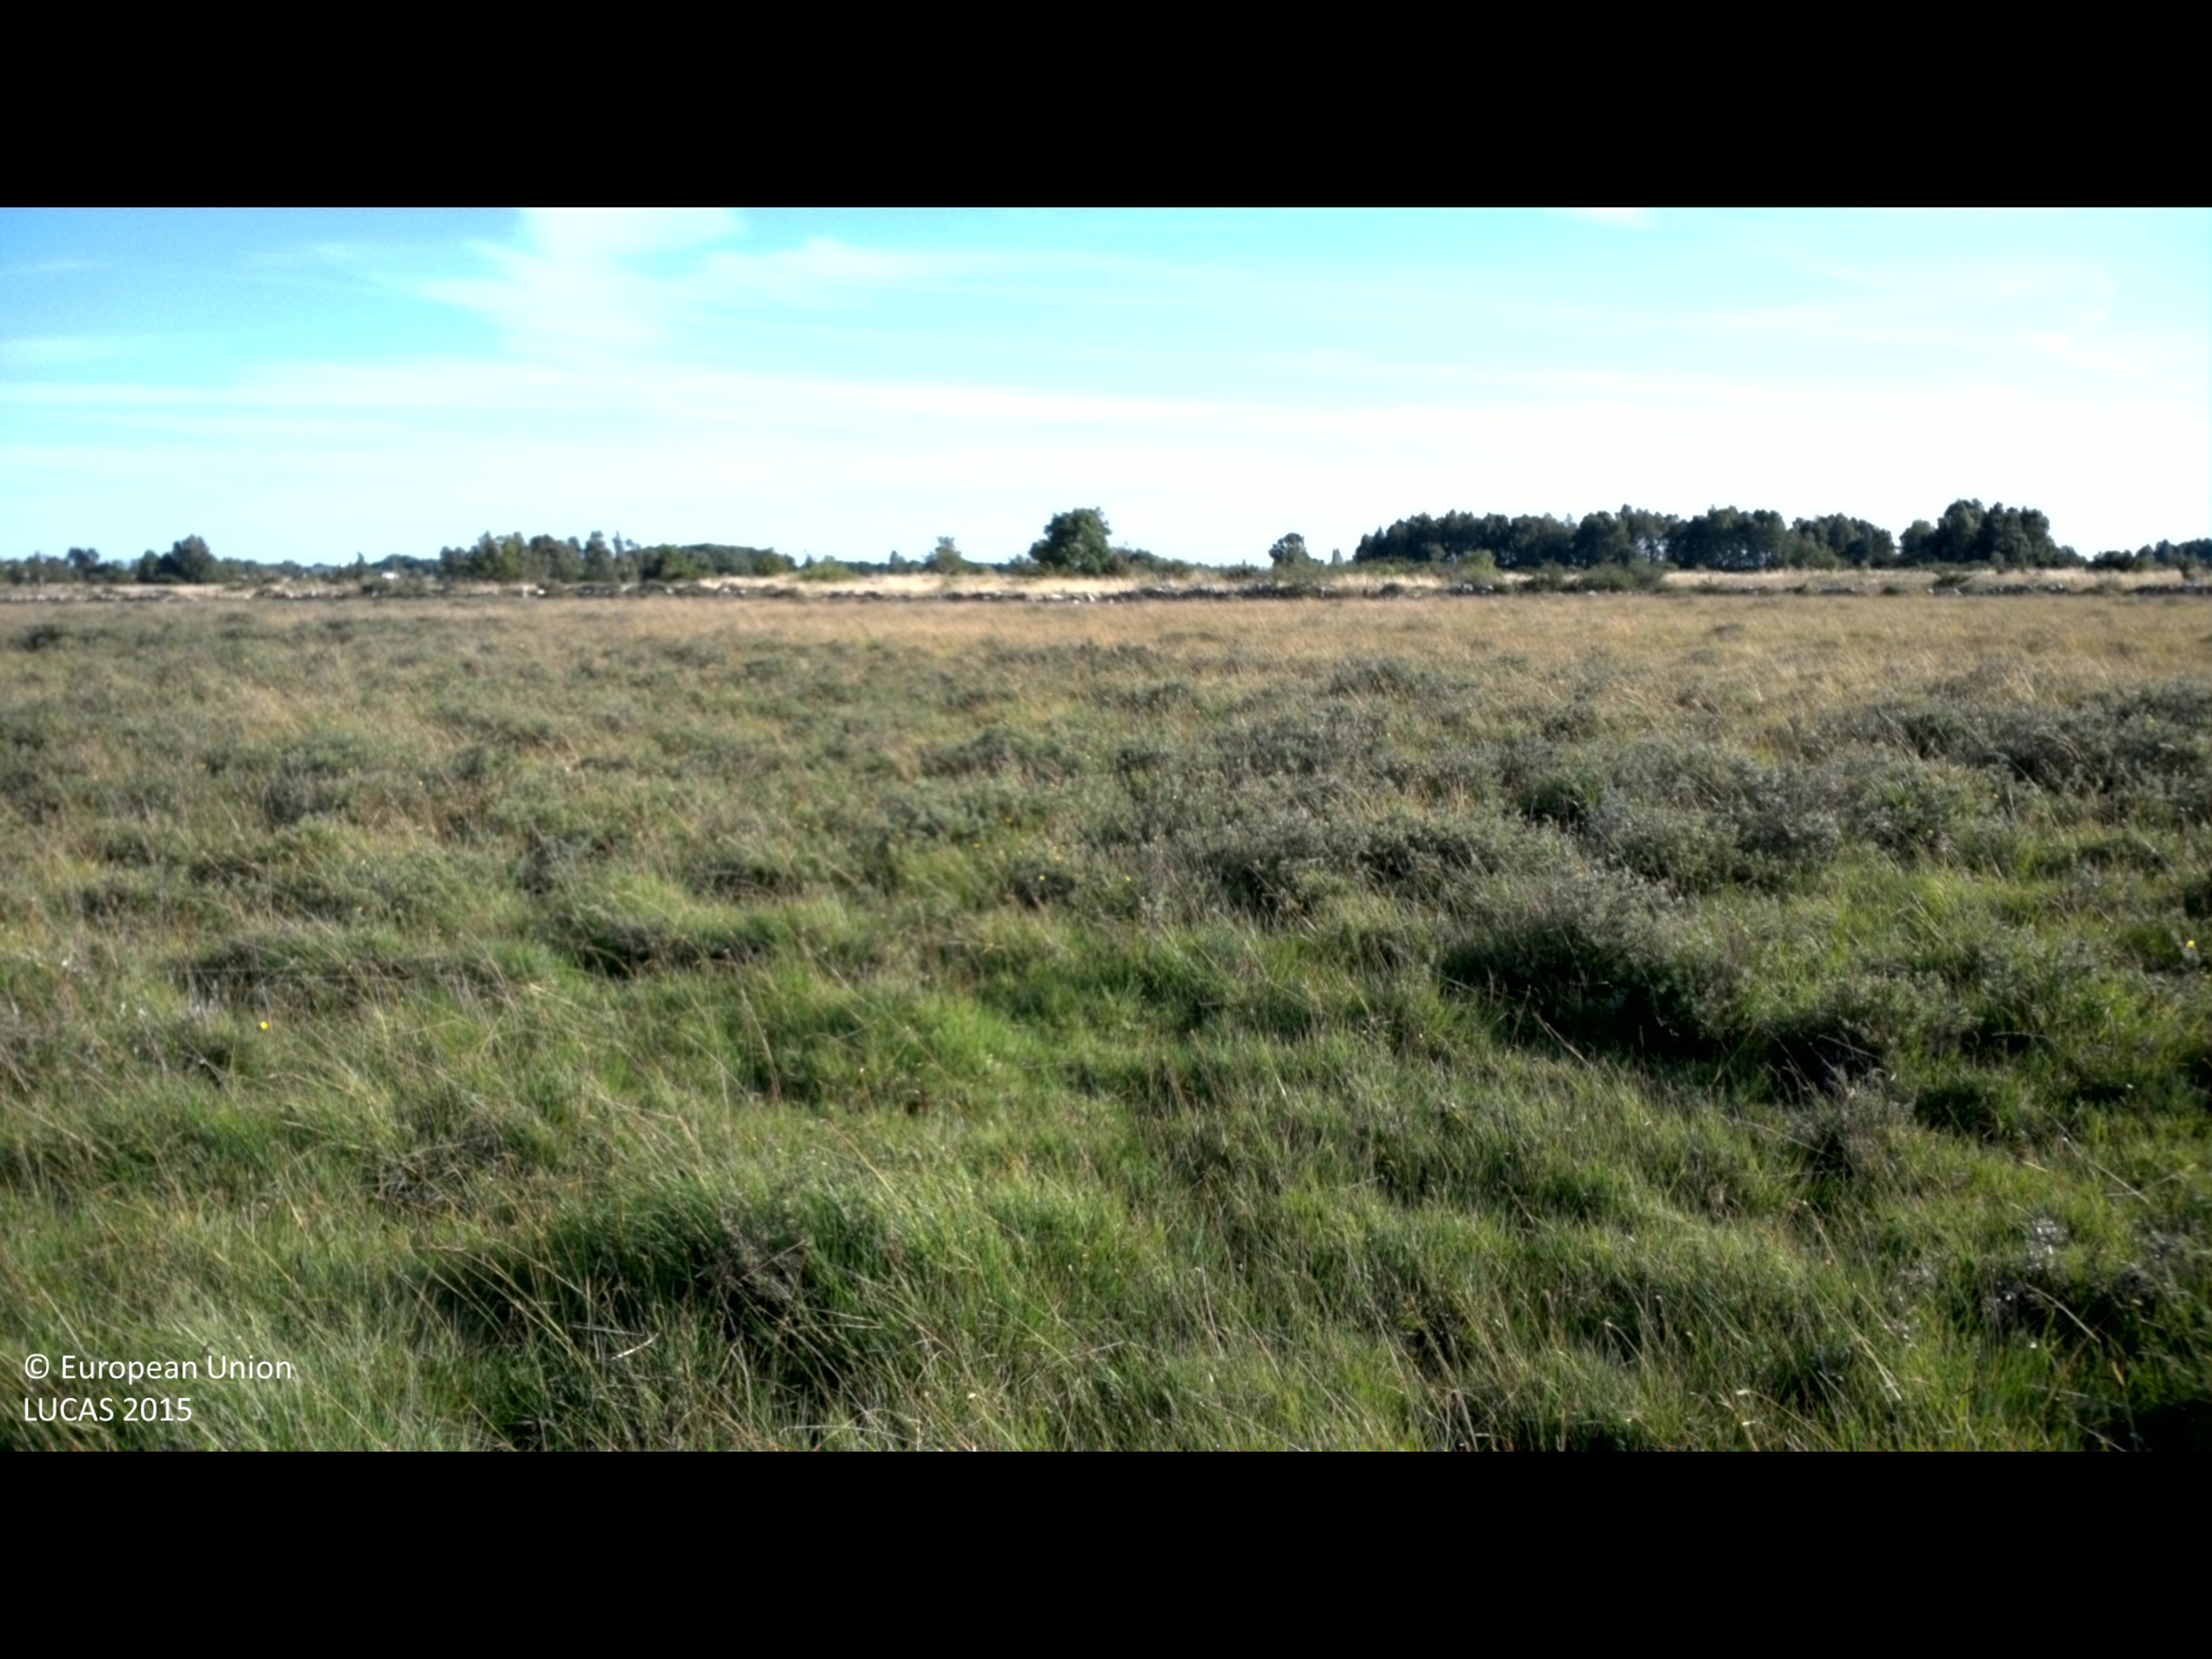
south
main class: Grassland
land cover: Grassland without tree/shrub cover
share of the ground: > 75 %
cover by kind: herbaceous plants 100 %
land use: Agriculture (excluding fallow land and kitchen gardens)
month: July
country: SE
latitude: 56.5239
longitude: 16.5855
